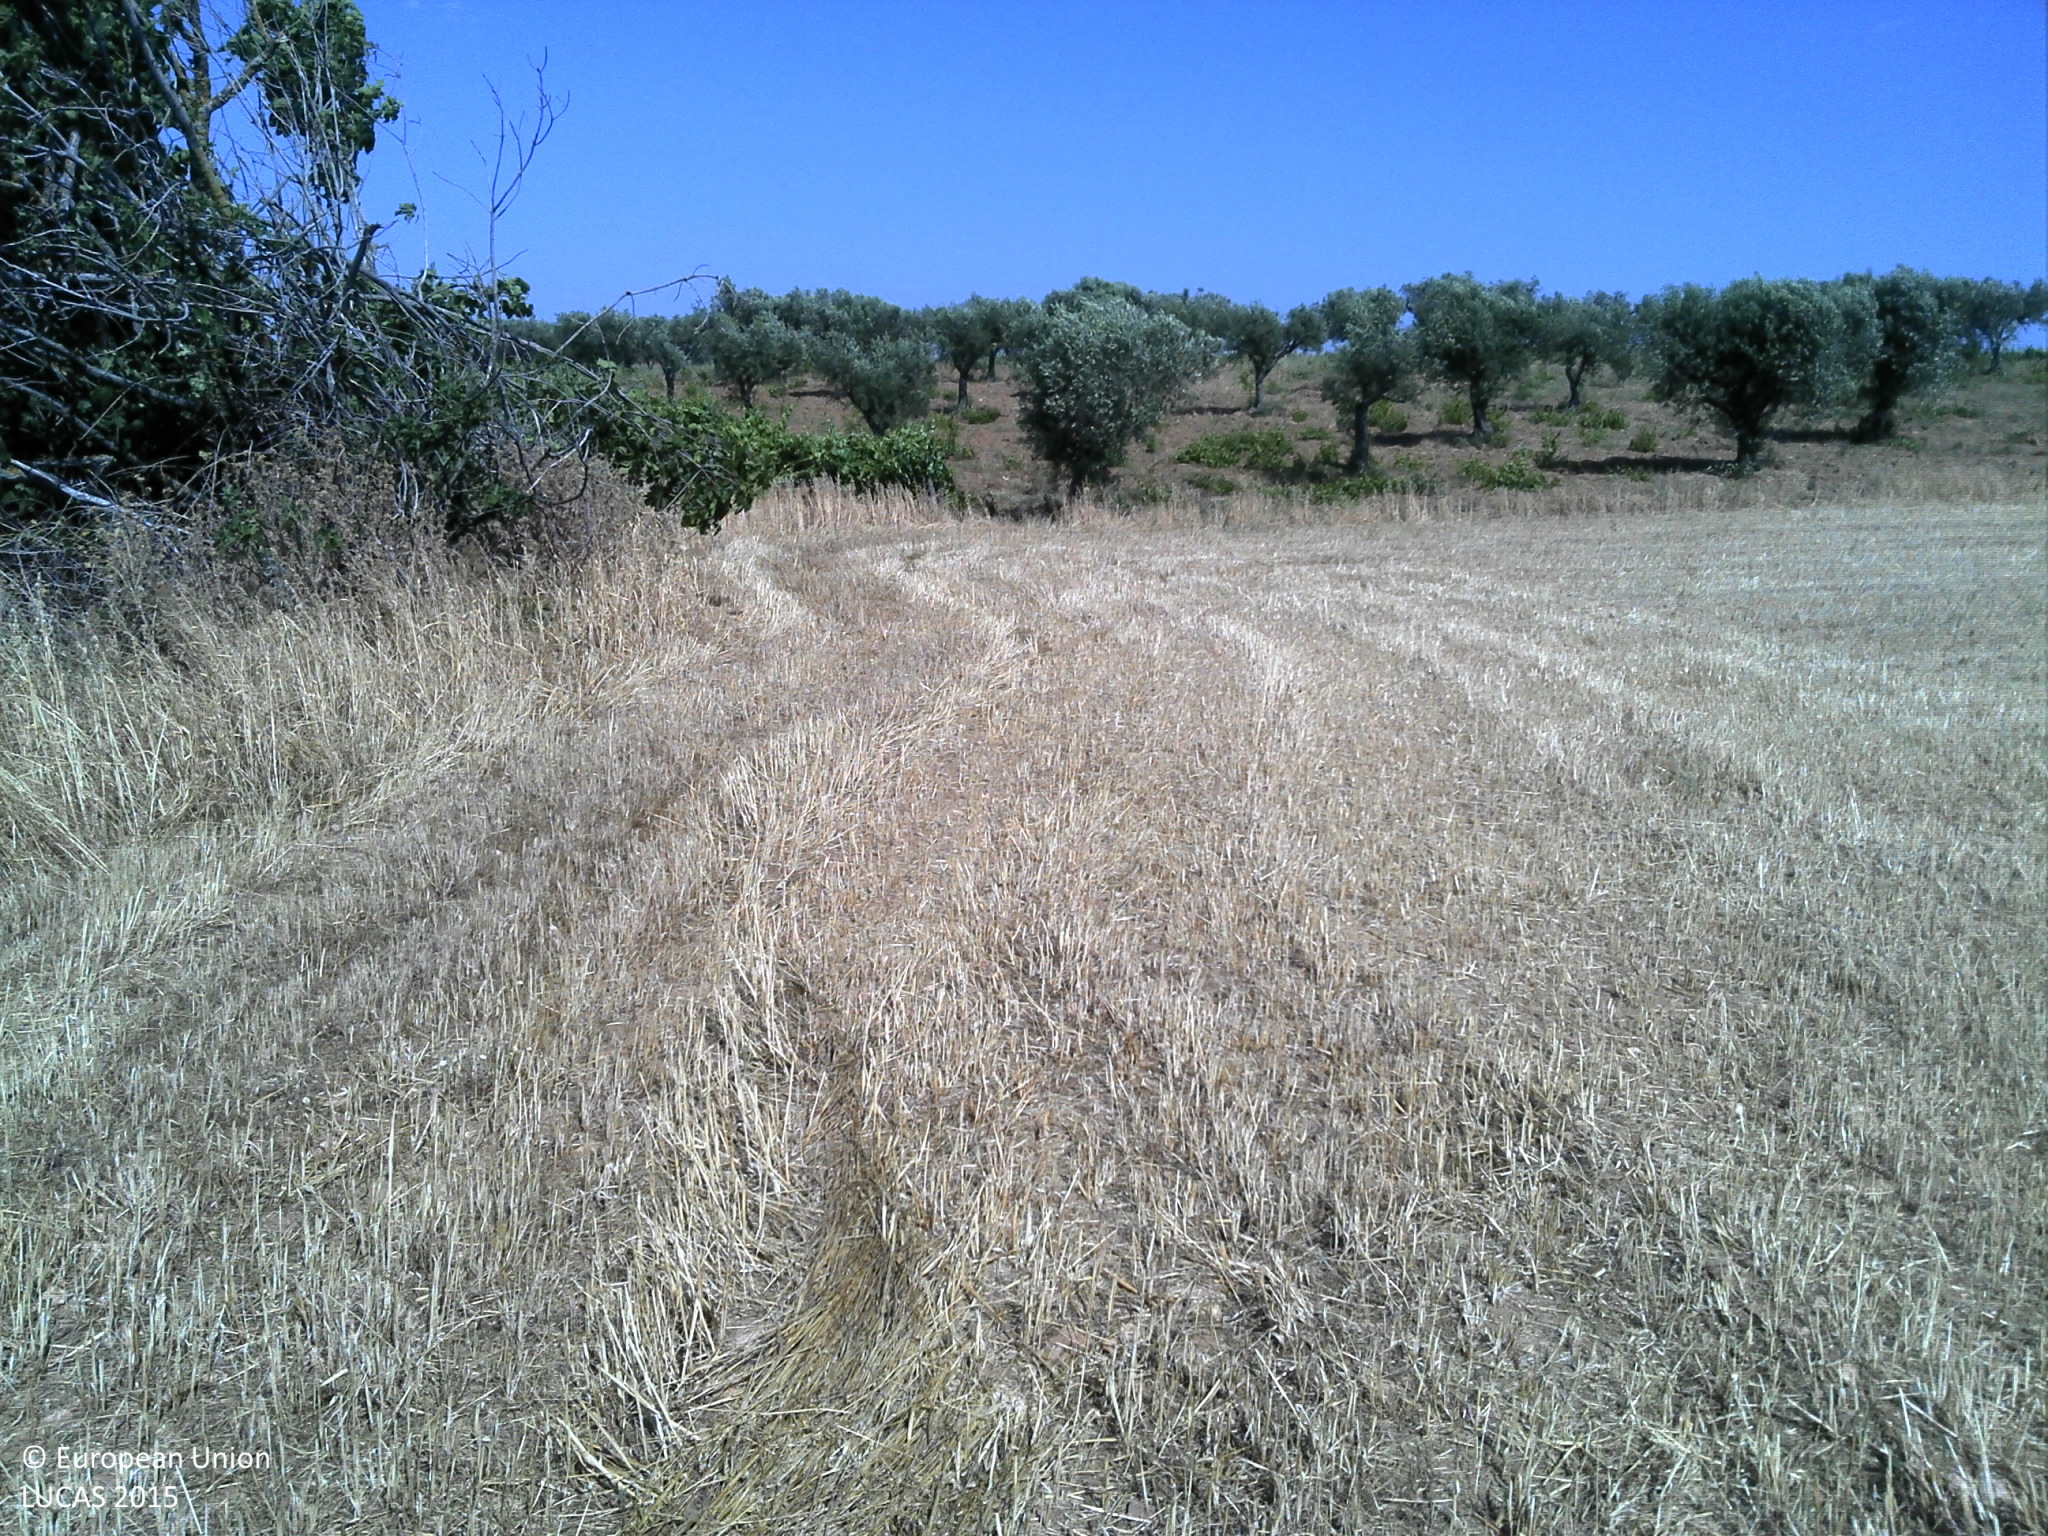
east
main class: Cropland
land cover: Oats
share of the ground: > 75 %
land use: Agriculture (excluding fallow land and kitchen gardens)
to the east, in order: Oats; Grass margins; Vineyards; Olive groves
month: June
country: PT
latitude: 40.8164
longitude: -6.9011
